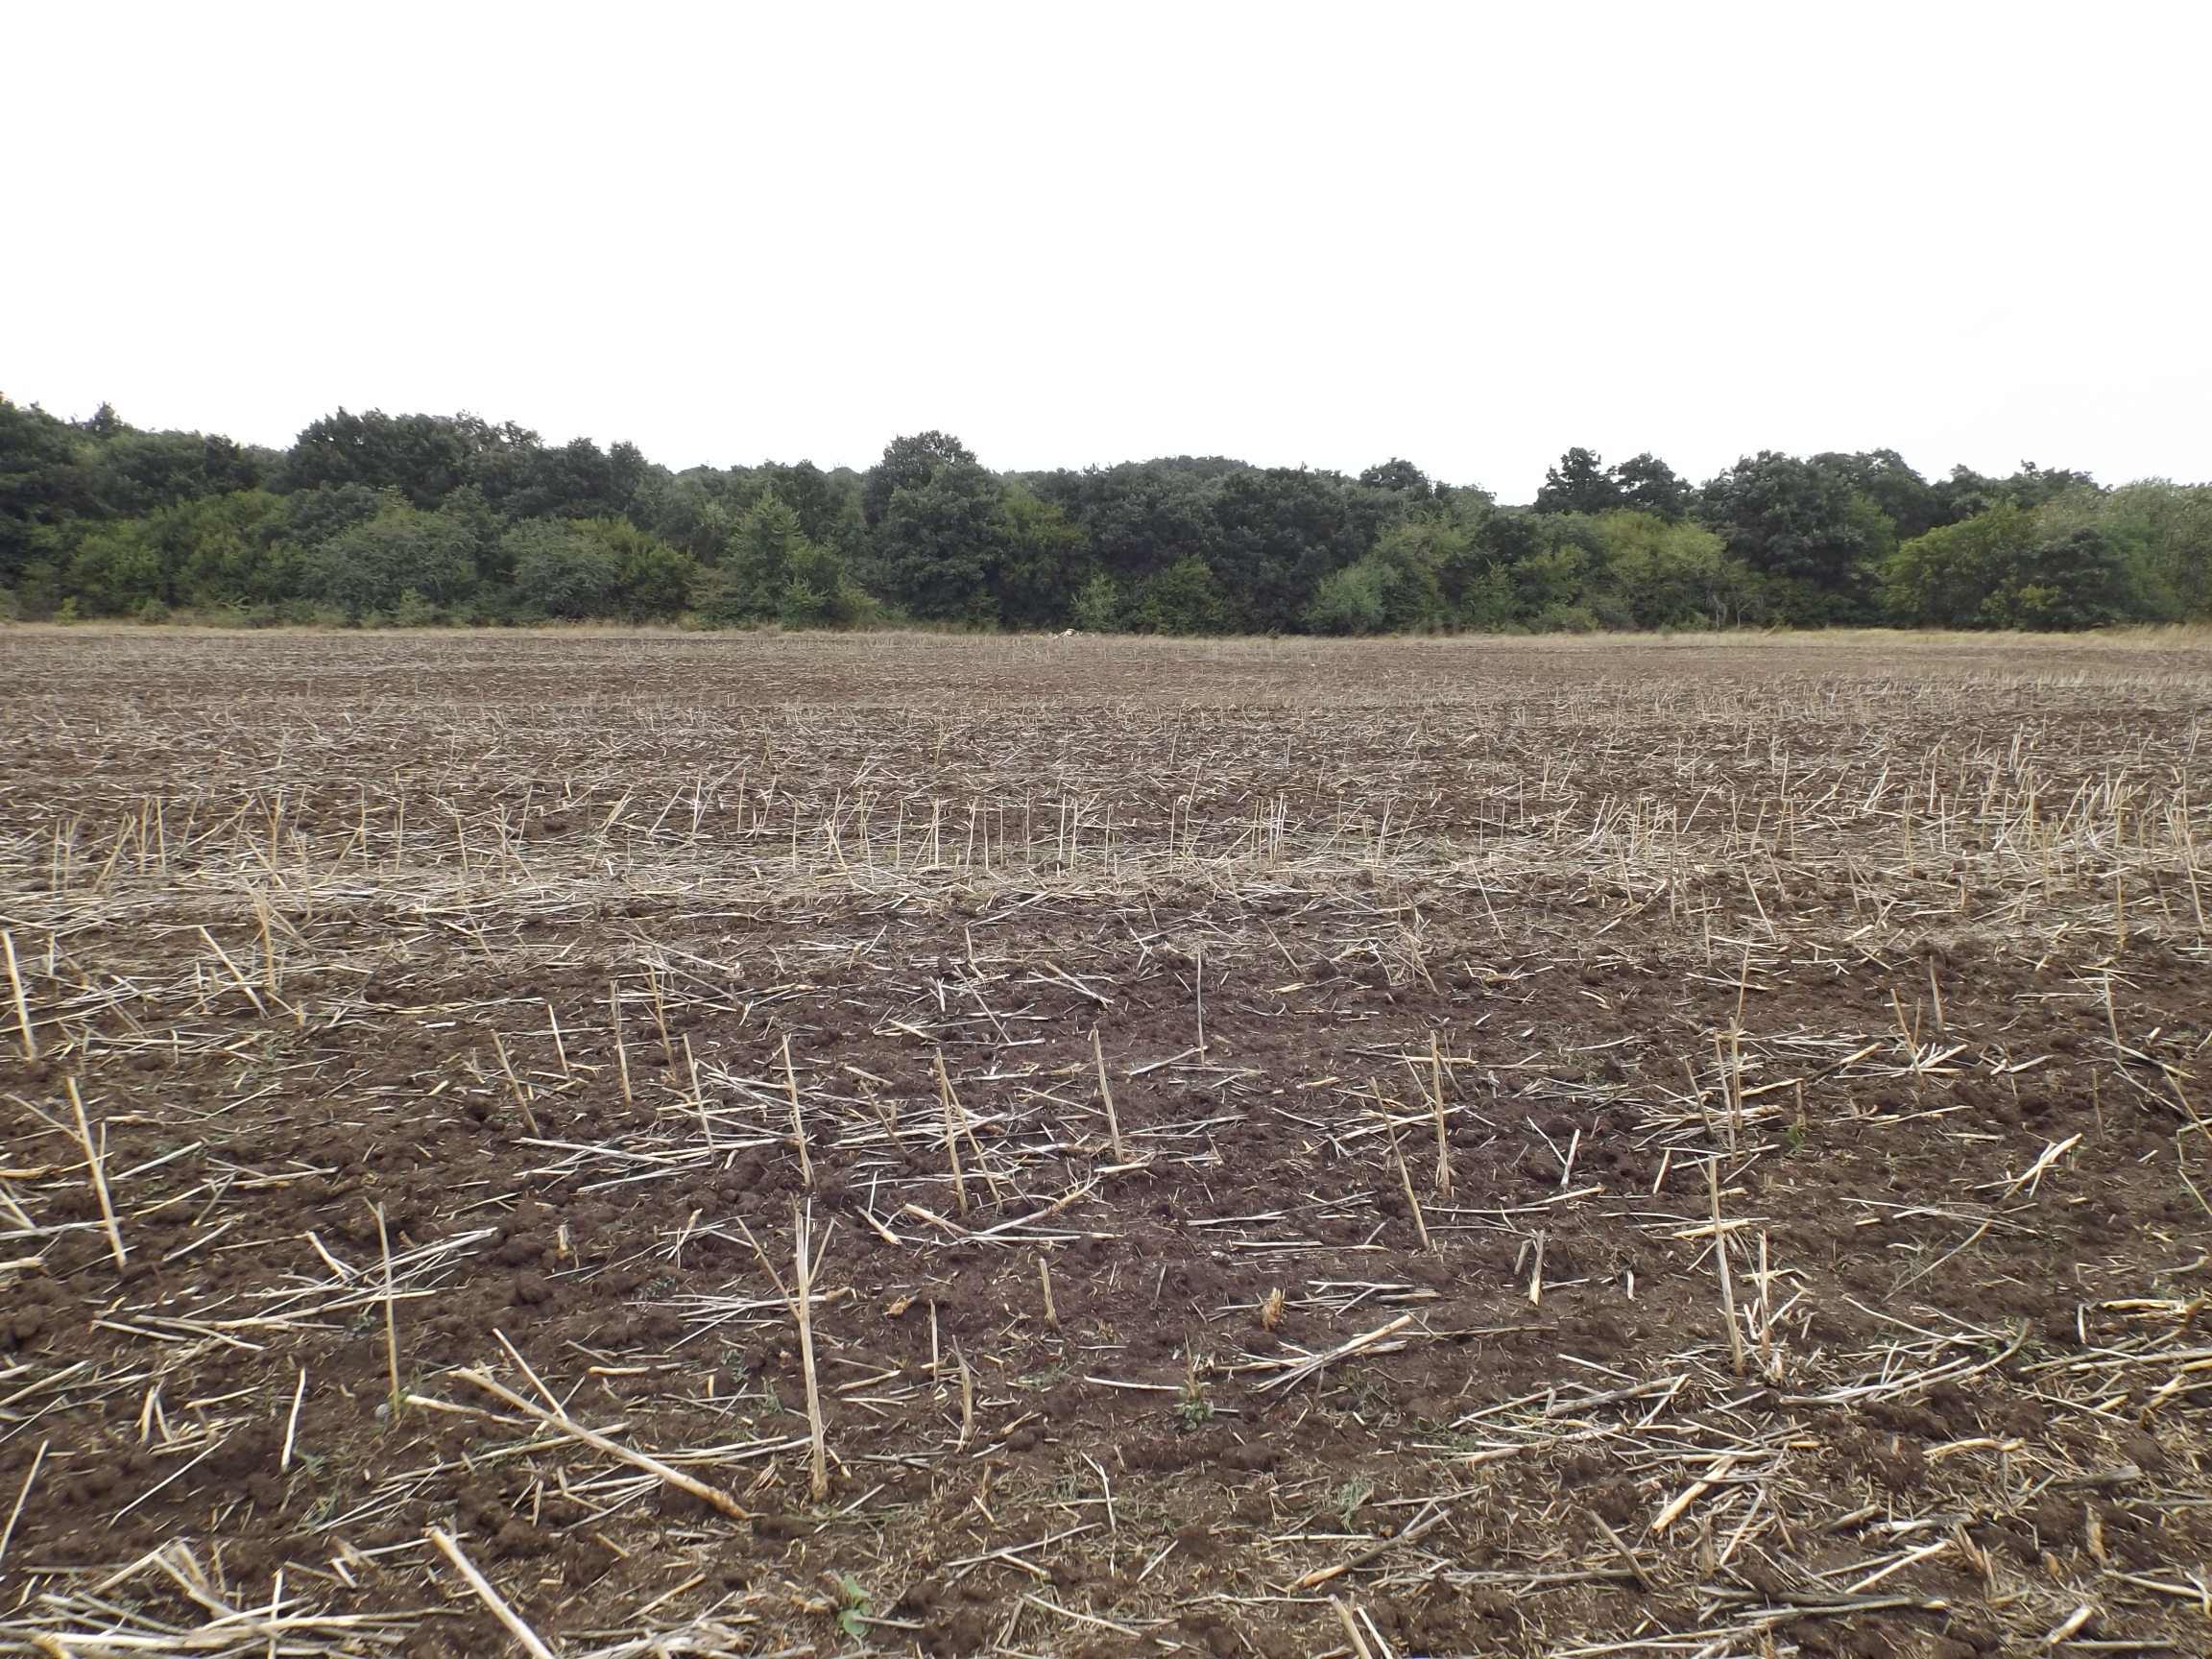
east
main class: Cropland
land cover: Maize
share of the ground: < 10 %
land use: Agriculture (excluding fallow land and kitchen gardens)
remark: Harvested field
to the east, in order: Maize; Grass margins; Tracks; Grass margins; Broadleaved woodland
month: August
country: BG
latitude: 43.1923
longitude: 27.5400
